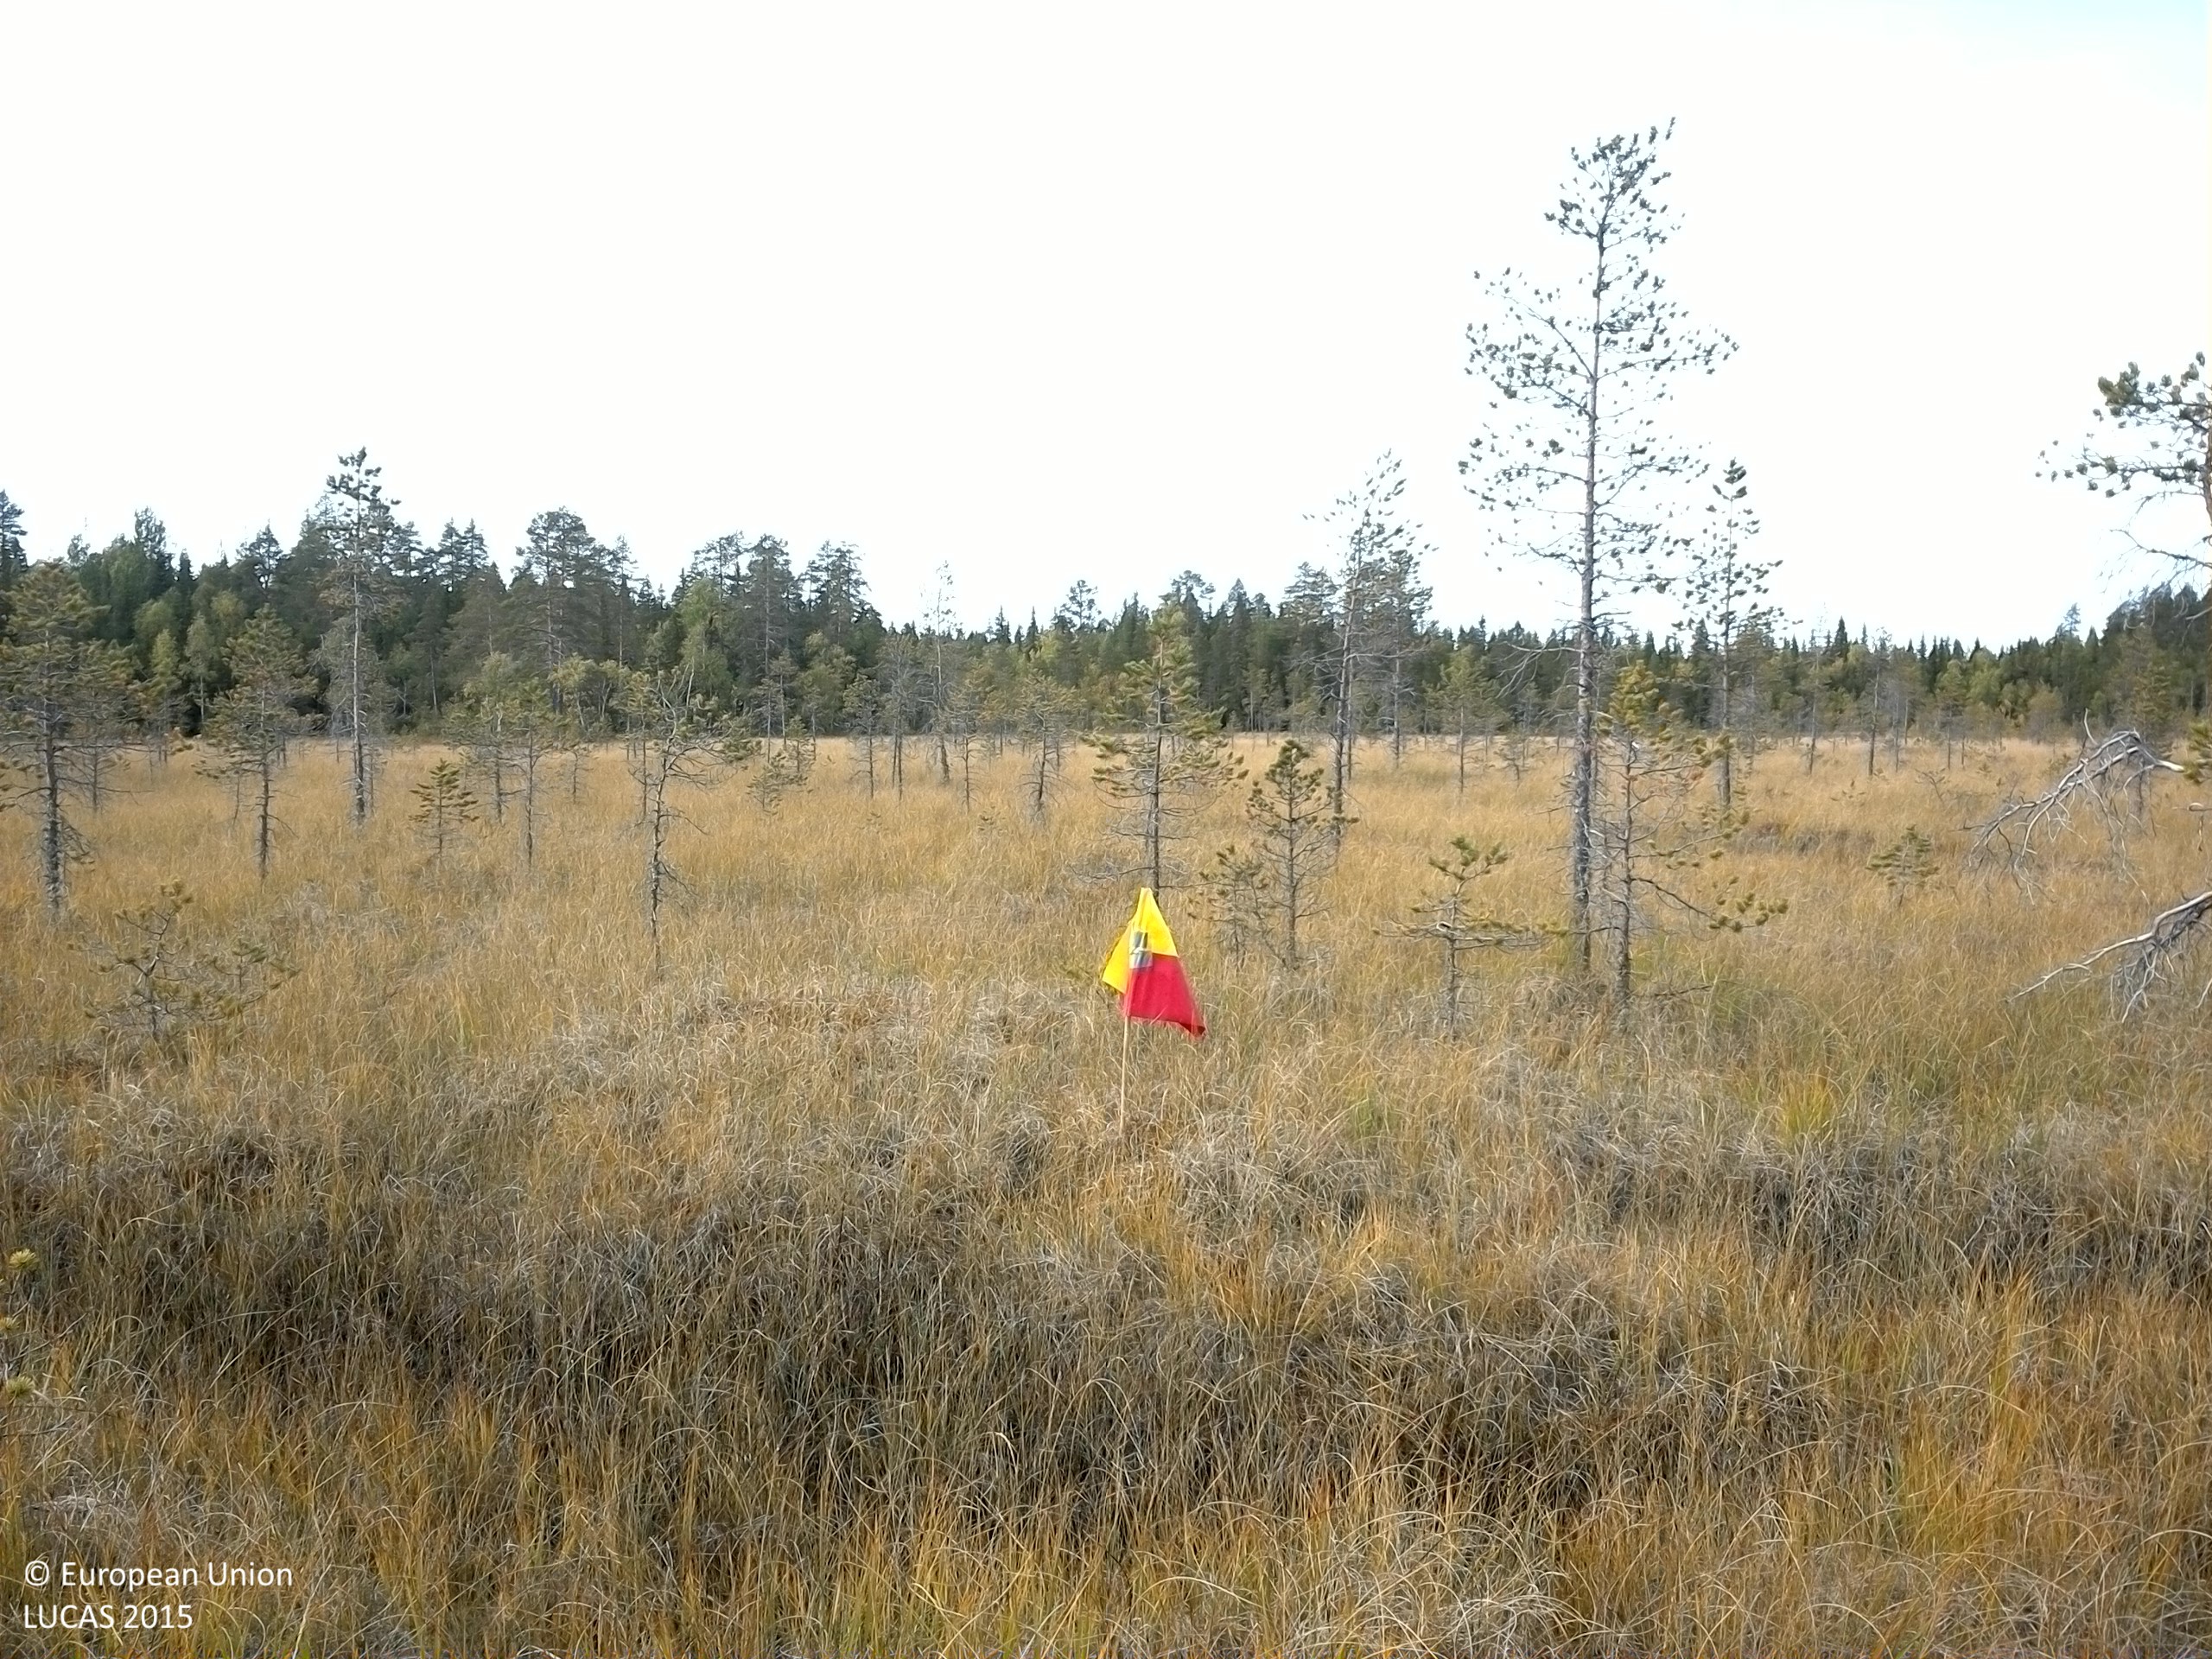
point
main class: Woodland
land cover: Pine dominated coniferous woodland
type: mire and swamp forests
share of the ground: 10 - 25 %
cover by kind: herbaceous plants 70 %, lichens and mosses 20 %, coniferous forest trees 10 %
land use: Semi-natural and natural areas not in use
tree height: < 5 m
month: September
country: SE
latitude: 64.0440
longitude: 16.5849
